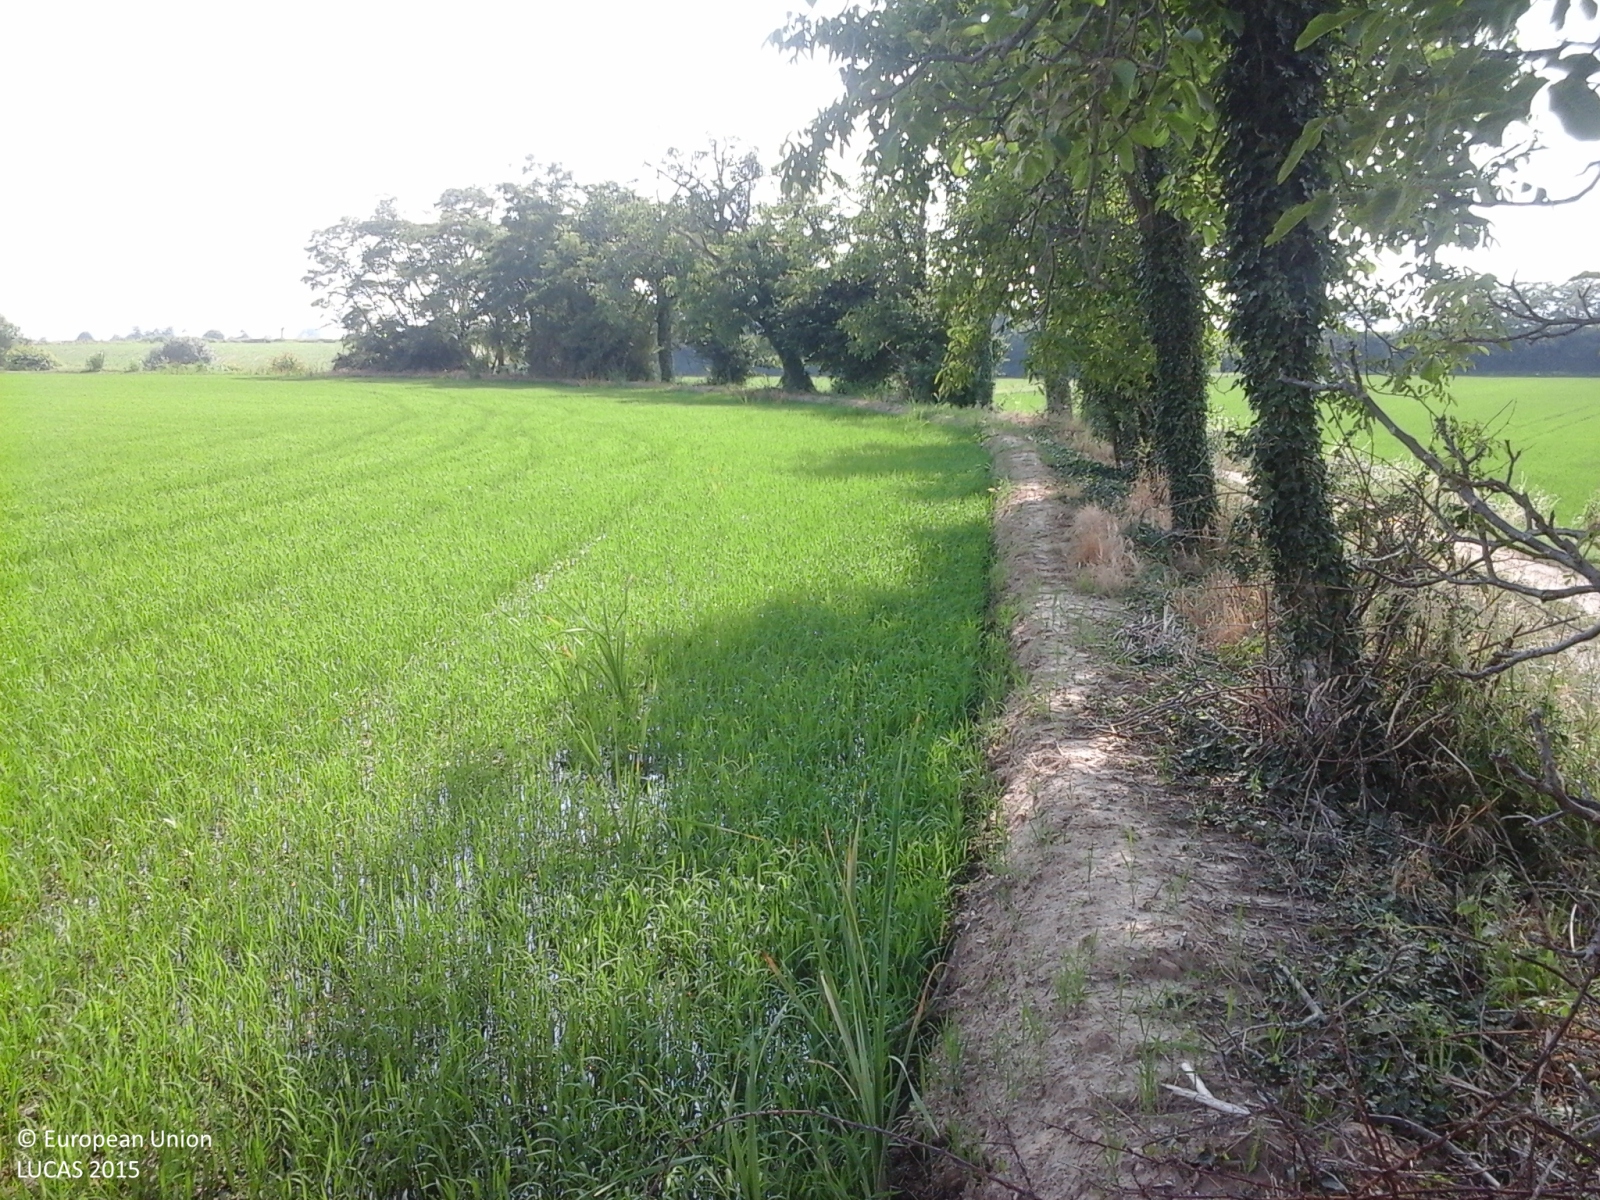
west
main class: Cropland
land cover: Rice
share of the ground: > 75 %
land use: Agriculture (excluding fallow land and kitchen gardens)
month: June
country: IT
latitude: 45.3694
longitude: 8.6362
